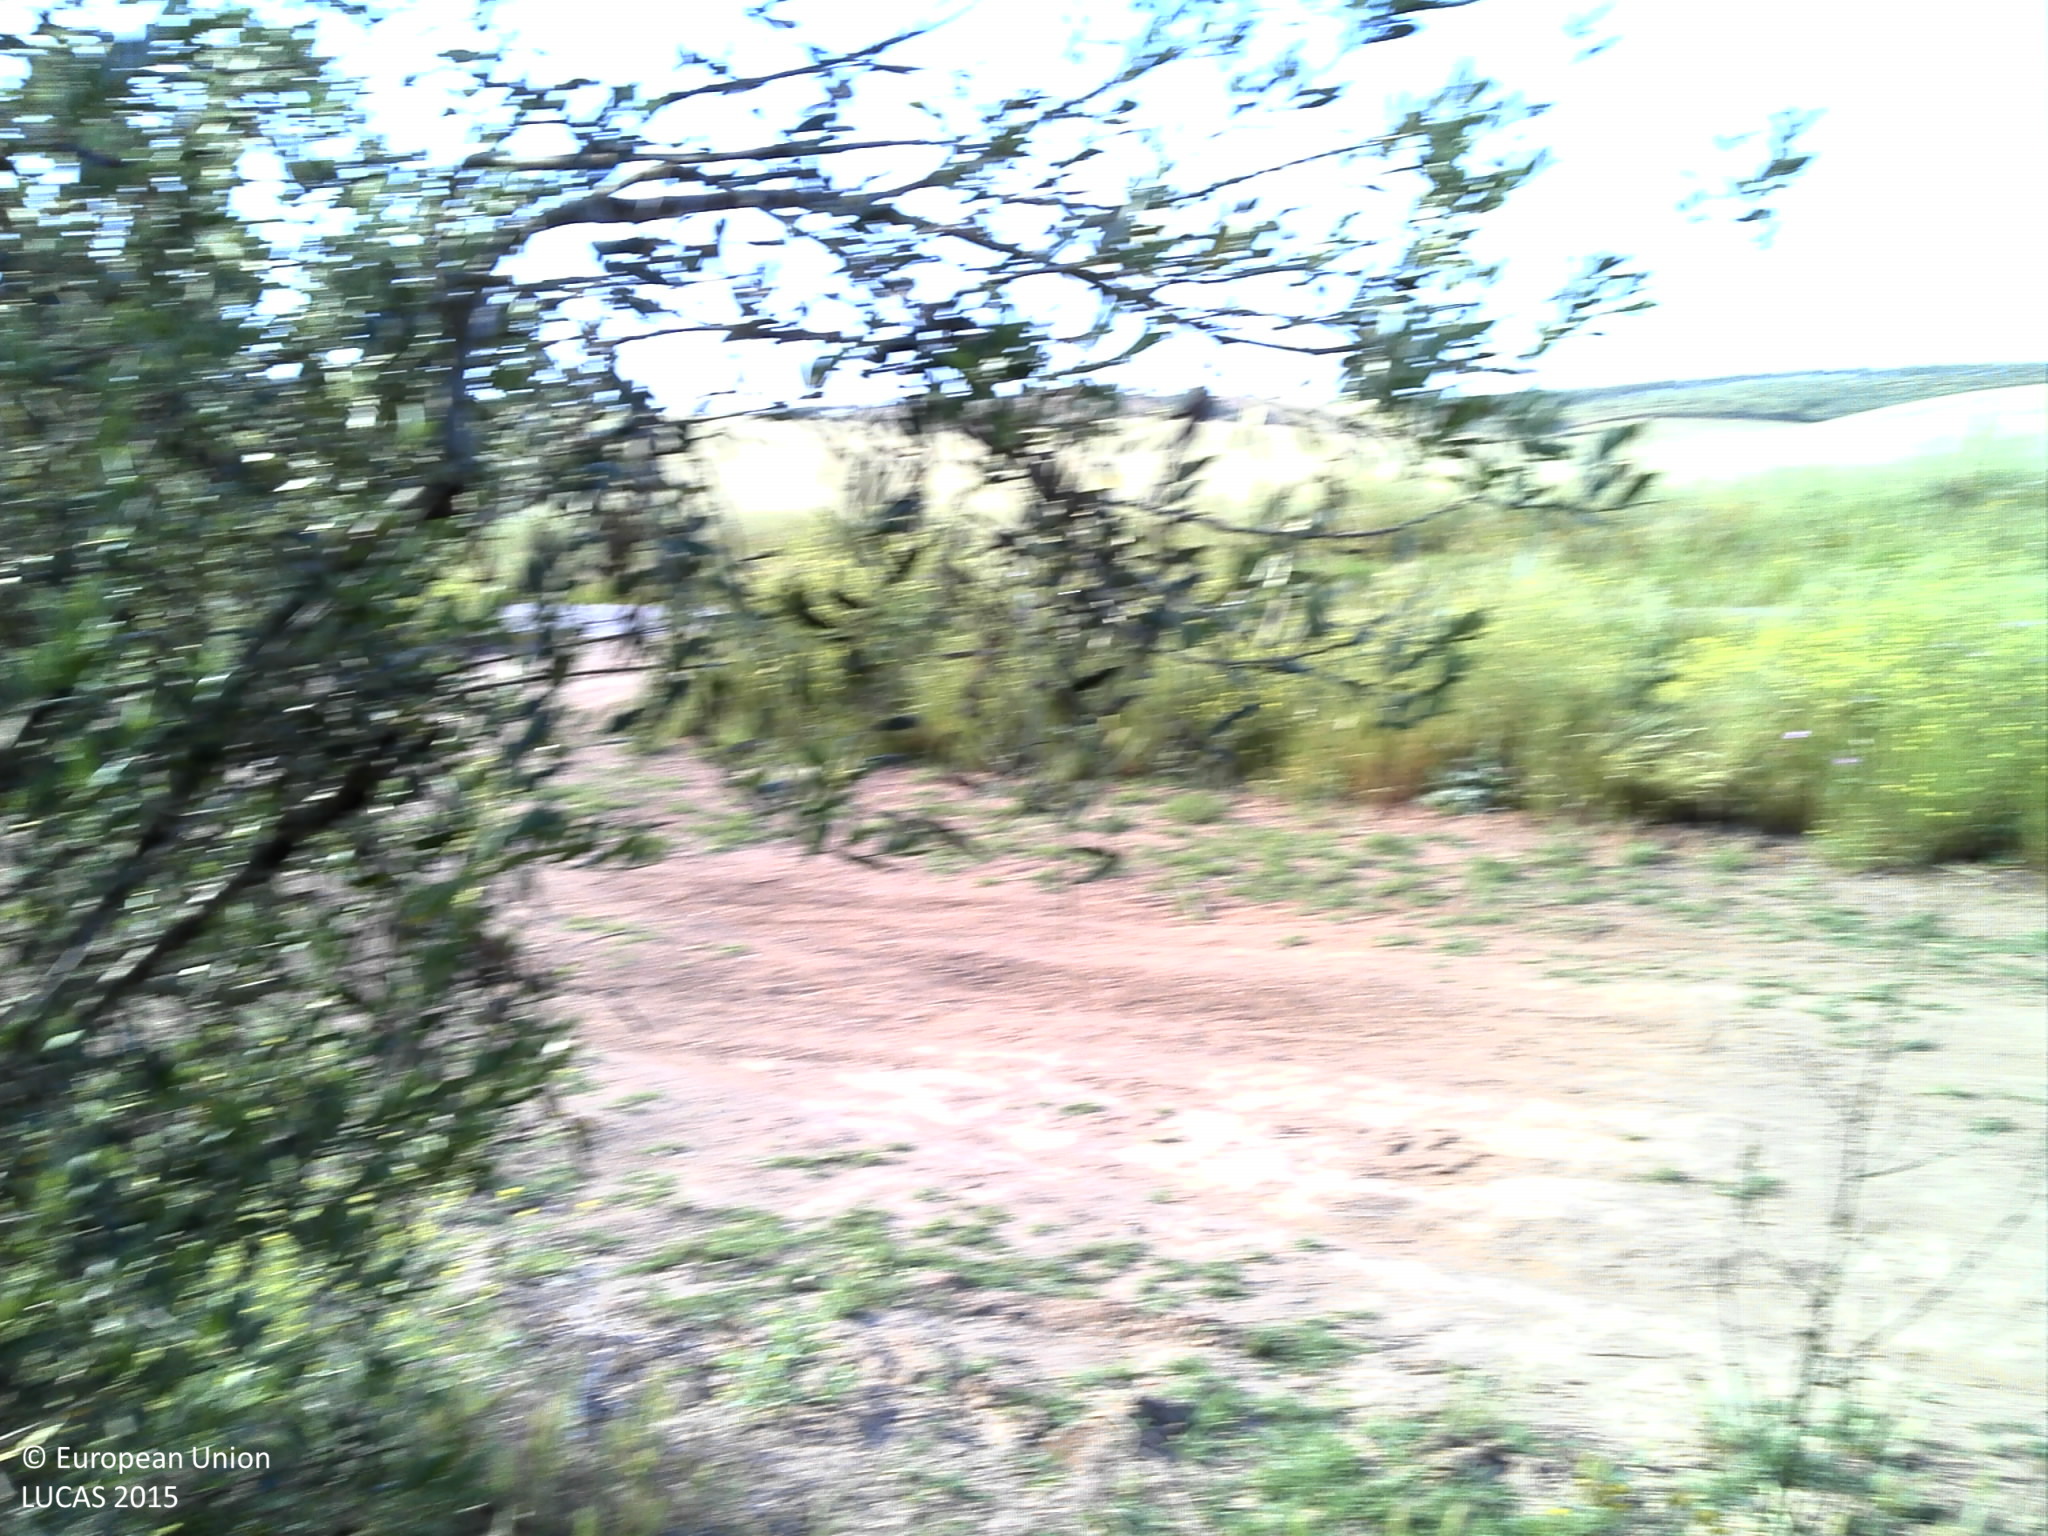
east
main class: Cropland
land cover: Olive groves
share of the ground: 25 - 50 %
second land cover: Grassland without tree/shrub cover
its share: 25 - 50 %
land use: Agriculture (excluding fallow land and kitchen gardens)
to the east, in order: Olive groves; Grassland without tree/shrub cover; Tracks; Olive groves
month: May
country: PT
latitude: 39.0445
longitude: -7.8280
